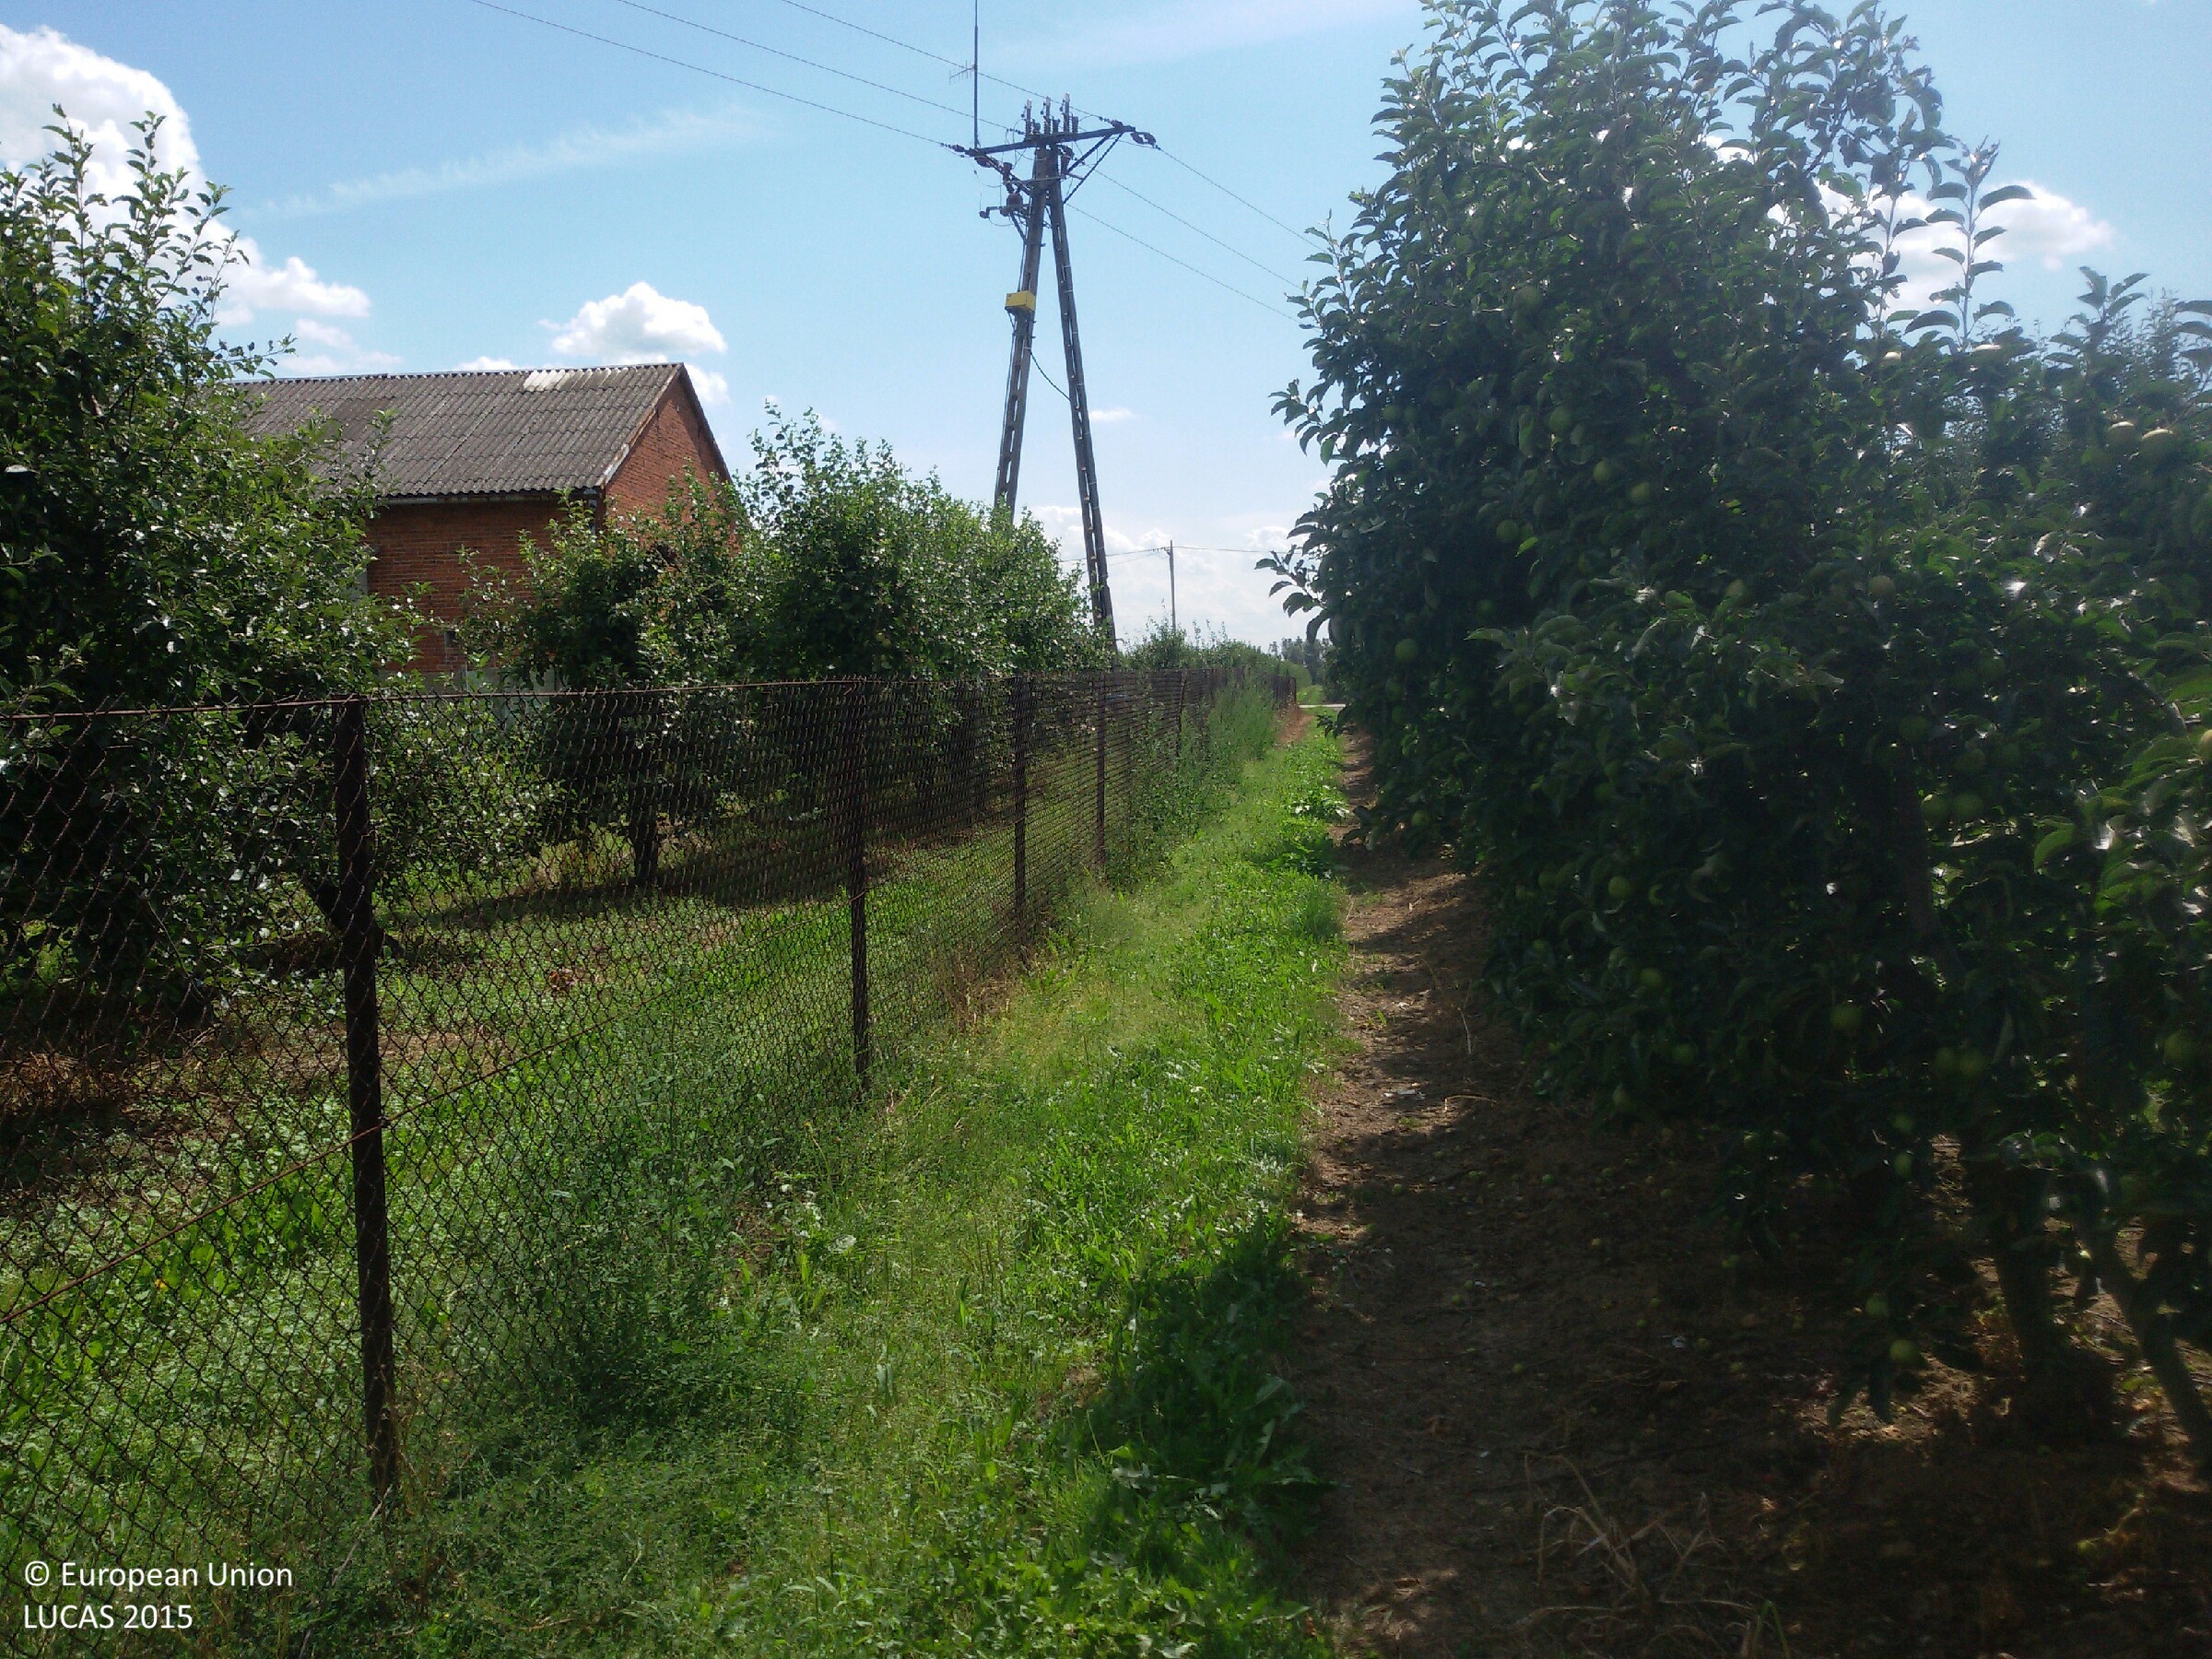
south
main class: Cropland
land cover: Apple fruit
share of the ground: > 75 %
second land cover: Grassland without tree/shrub cover
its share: > 75 %
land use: Agriculture (excluding fallow land and kitchen gardens)
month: July
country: PL
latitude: 50.6374
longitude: 21.6616
